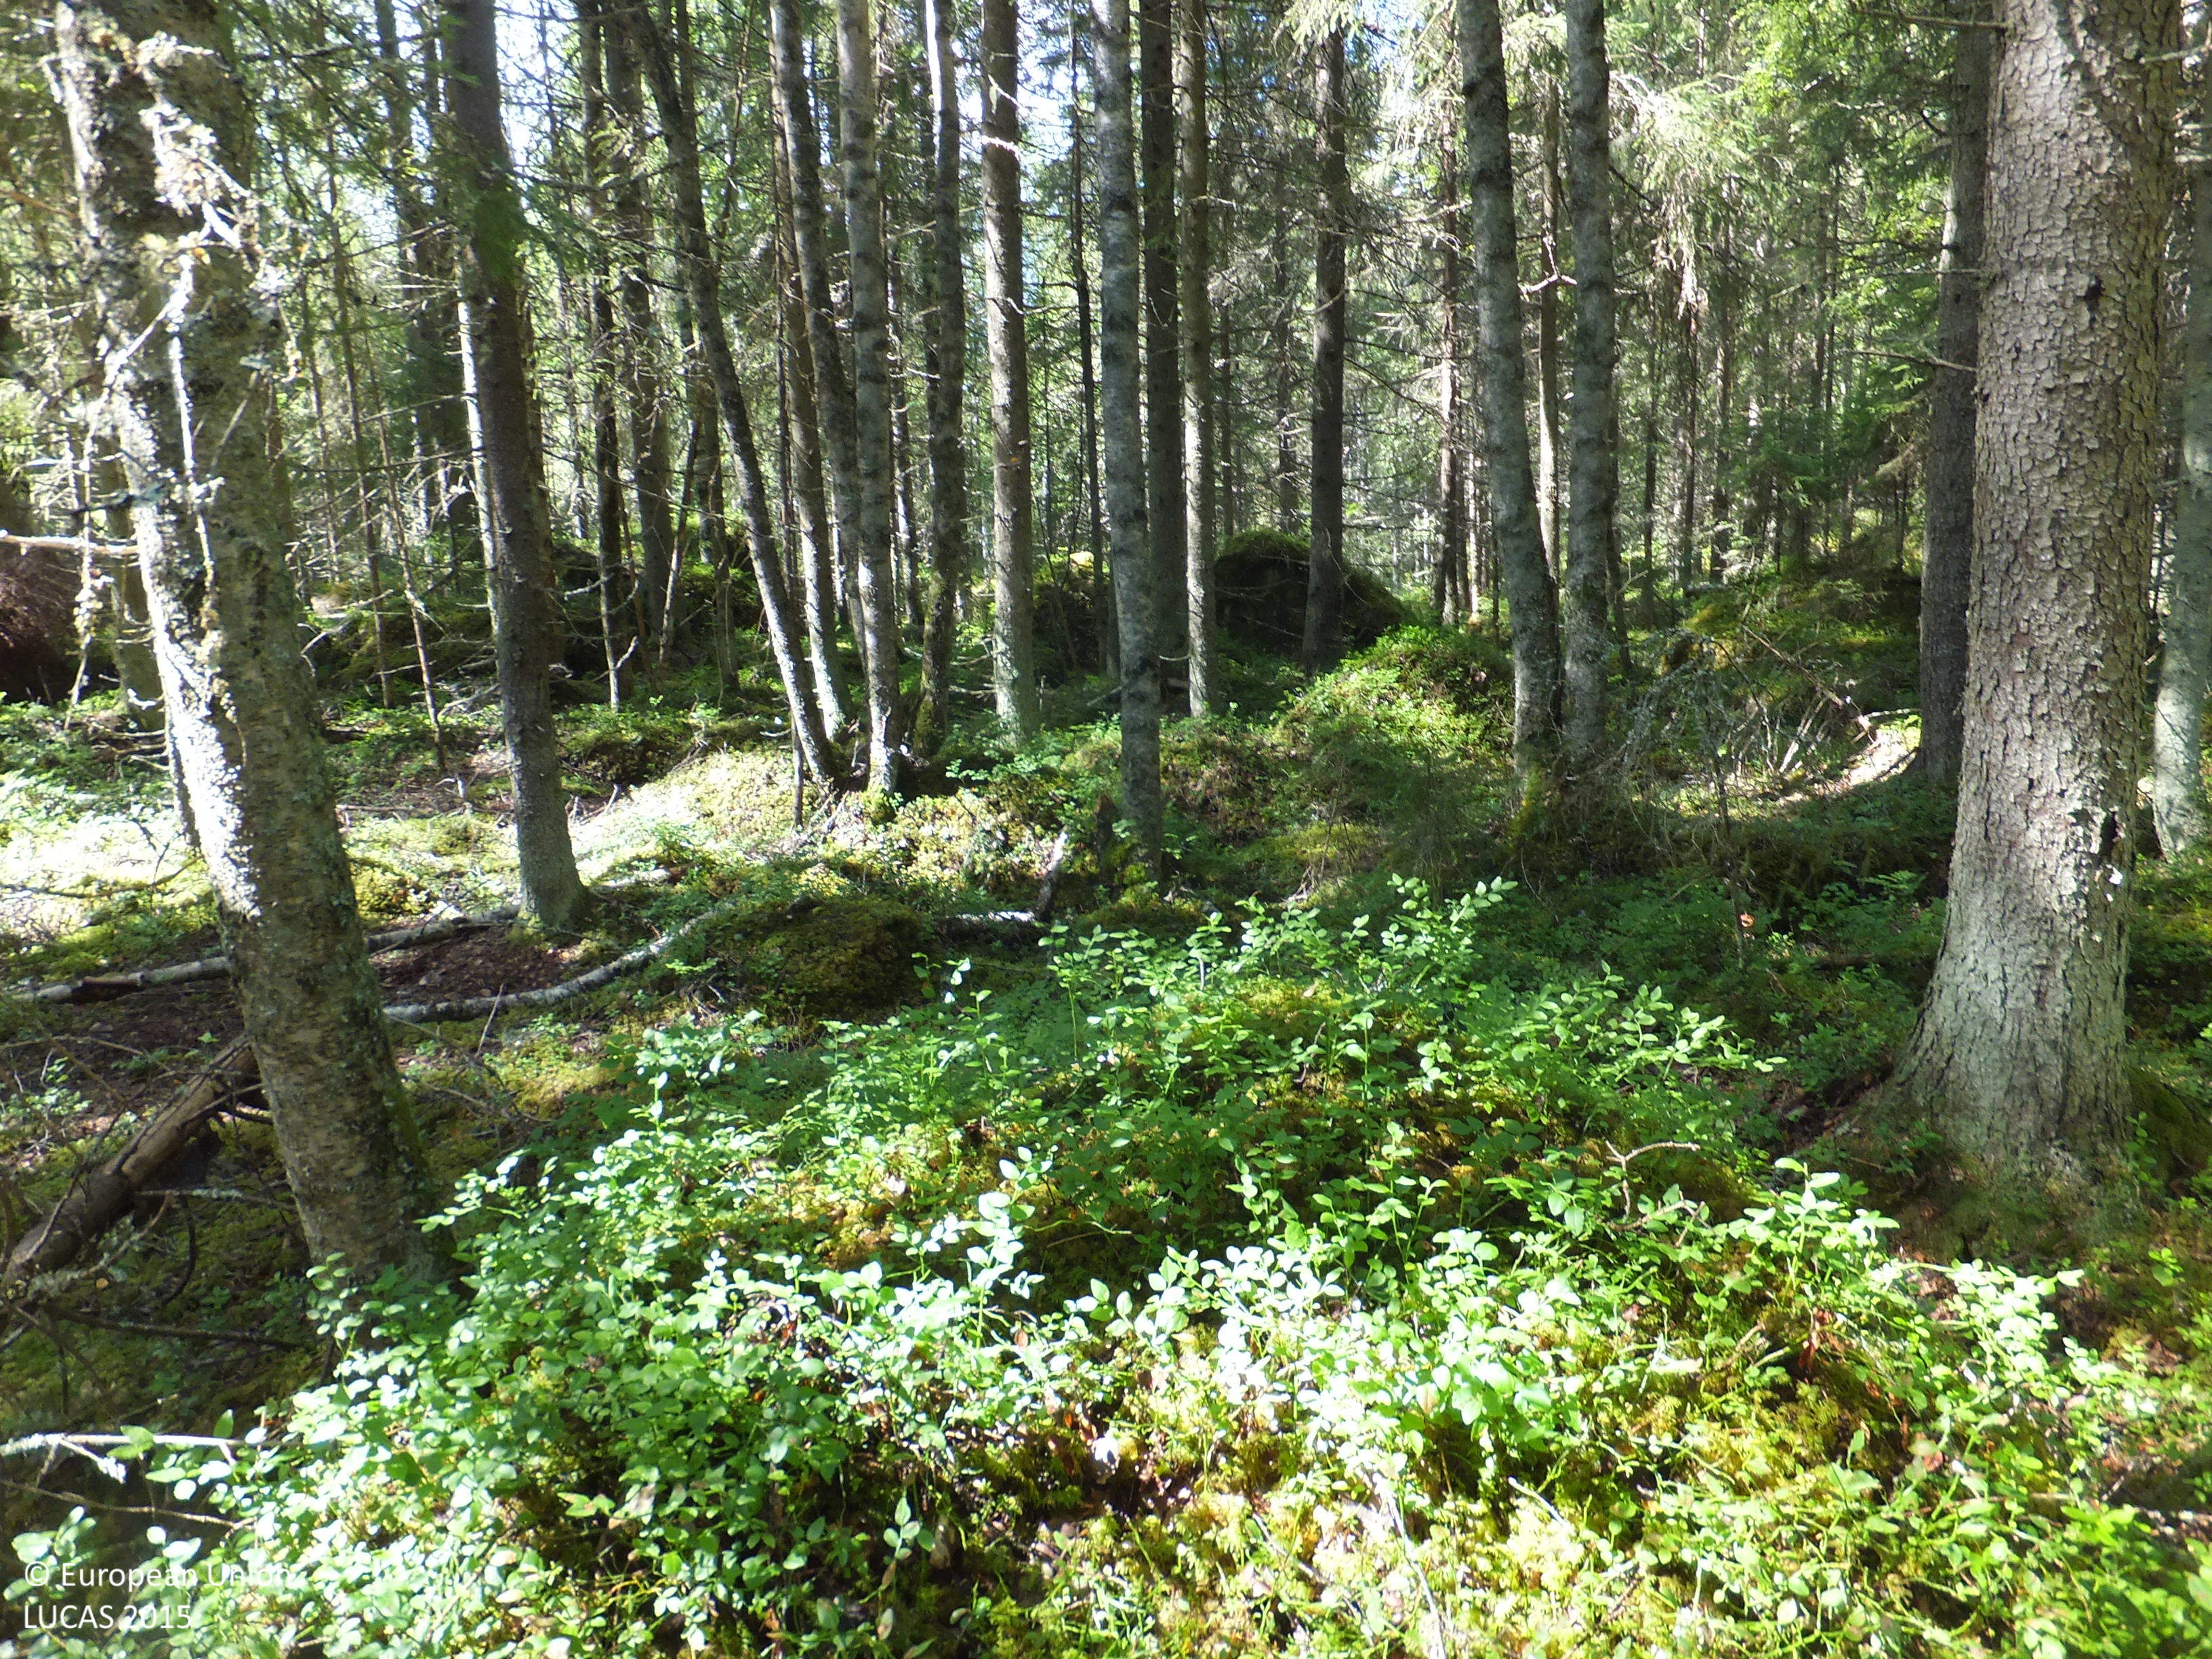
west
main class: Woodland
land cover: Spruce dominated mixed woodland
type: boreal forest
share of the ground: > 75 %
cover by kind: coniferous forest trees 50 %, broadleaved forest trees 30 %, shrubs 10 %, lichens and mosses 10 %
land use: Forestry
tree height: > 5 m
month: August
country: FI
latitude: 63.0994
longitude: 22.2310
